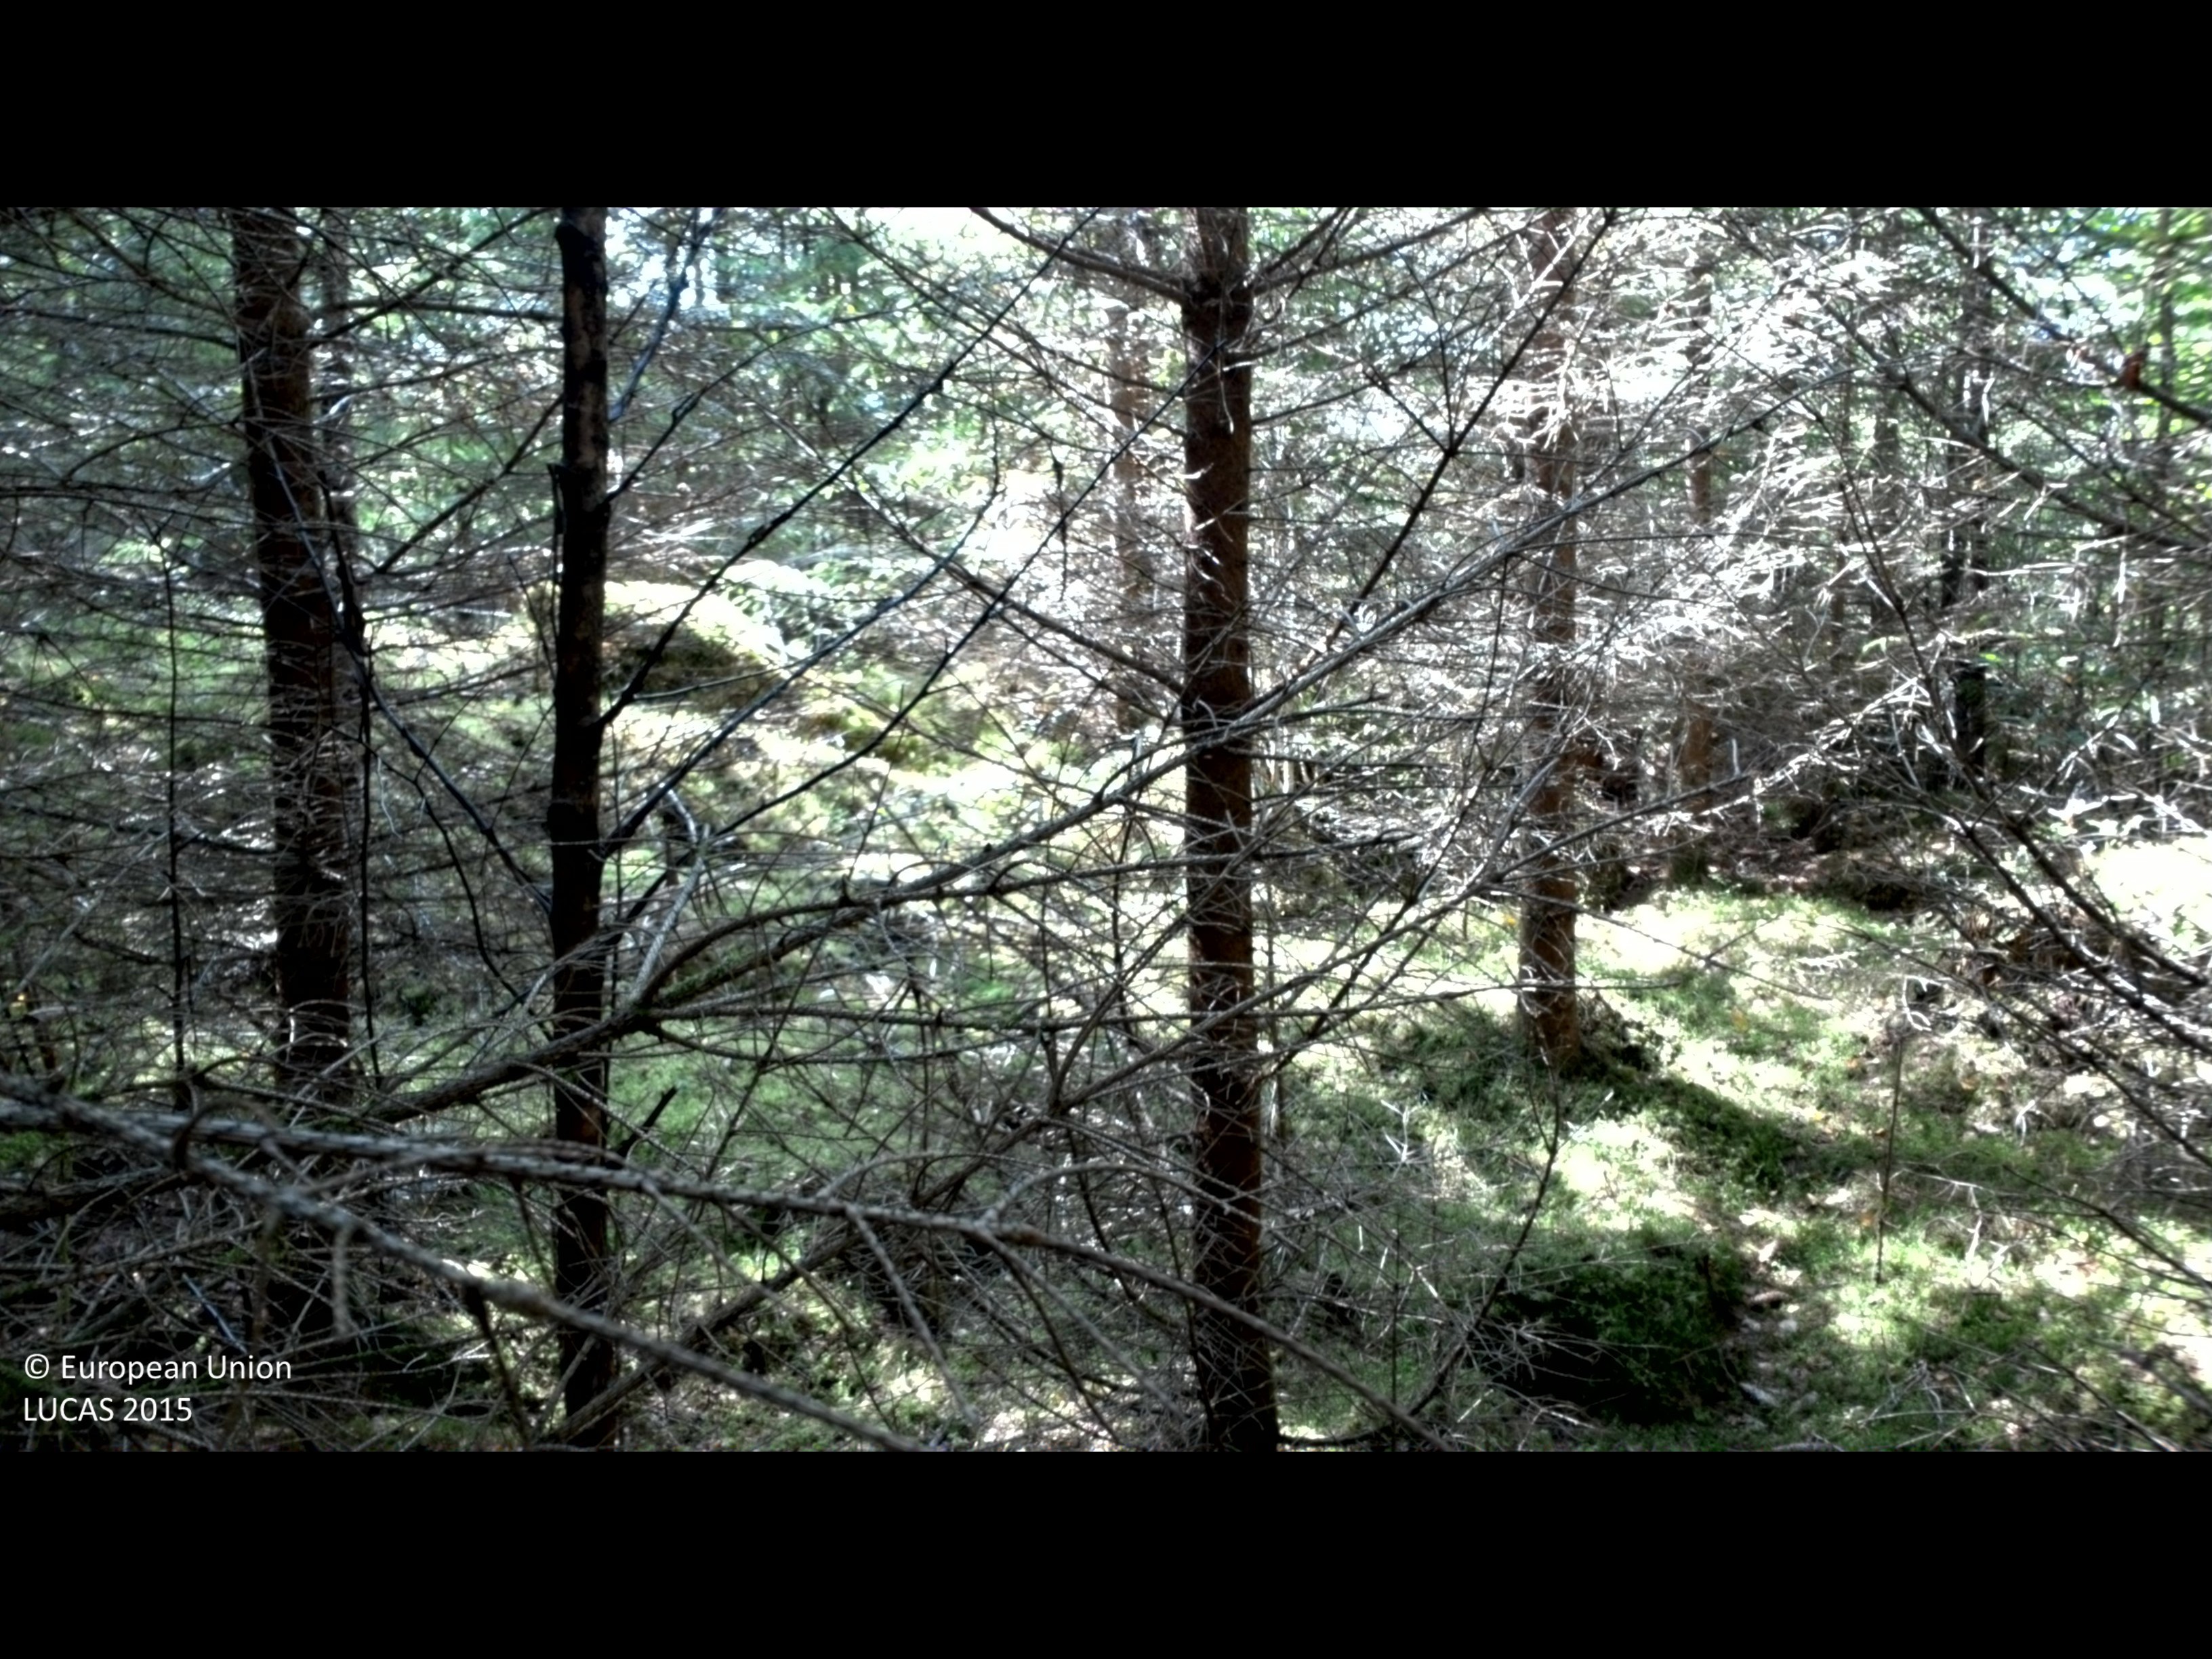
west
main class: Woodland
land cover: Spruce dominated coniferous woodland
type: boreal forest
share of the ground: > 75 %
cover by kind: coniferous forest trees 90 %, lichens and mosses 10 %
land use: Forestry
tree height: < 5 m
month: August
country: SE
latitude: 56.3953
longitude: 14.5501
